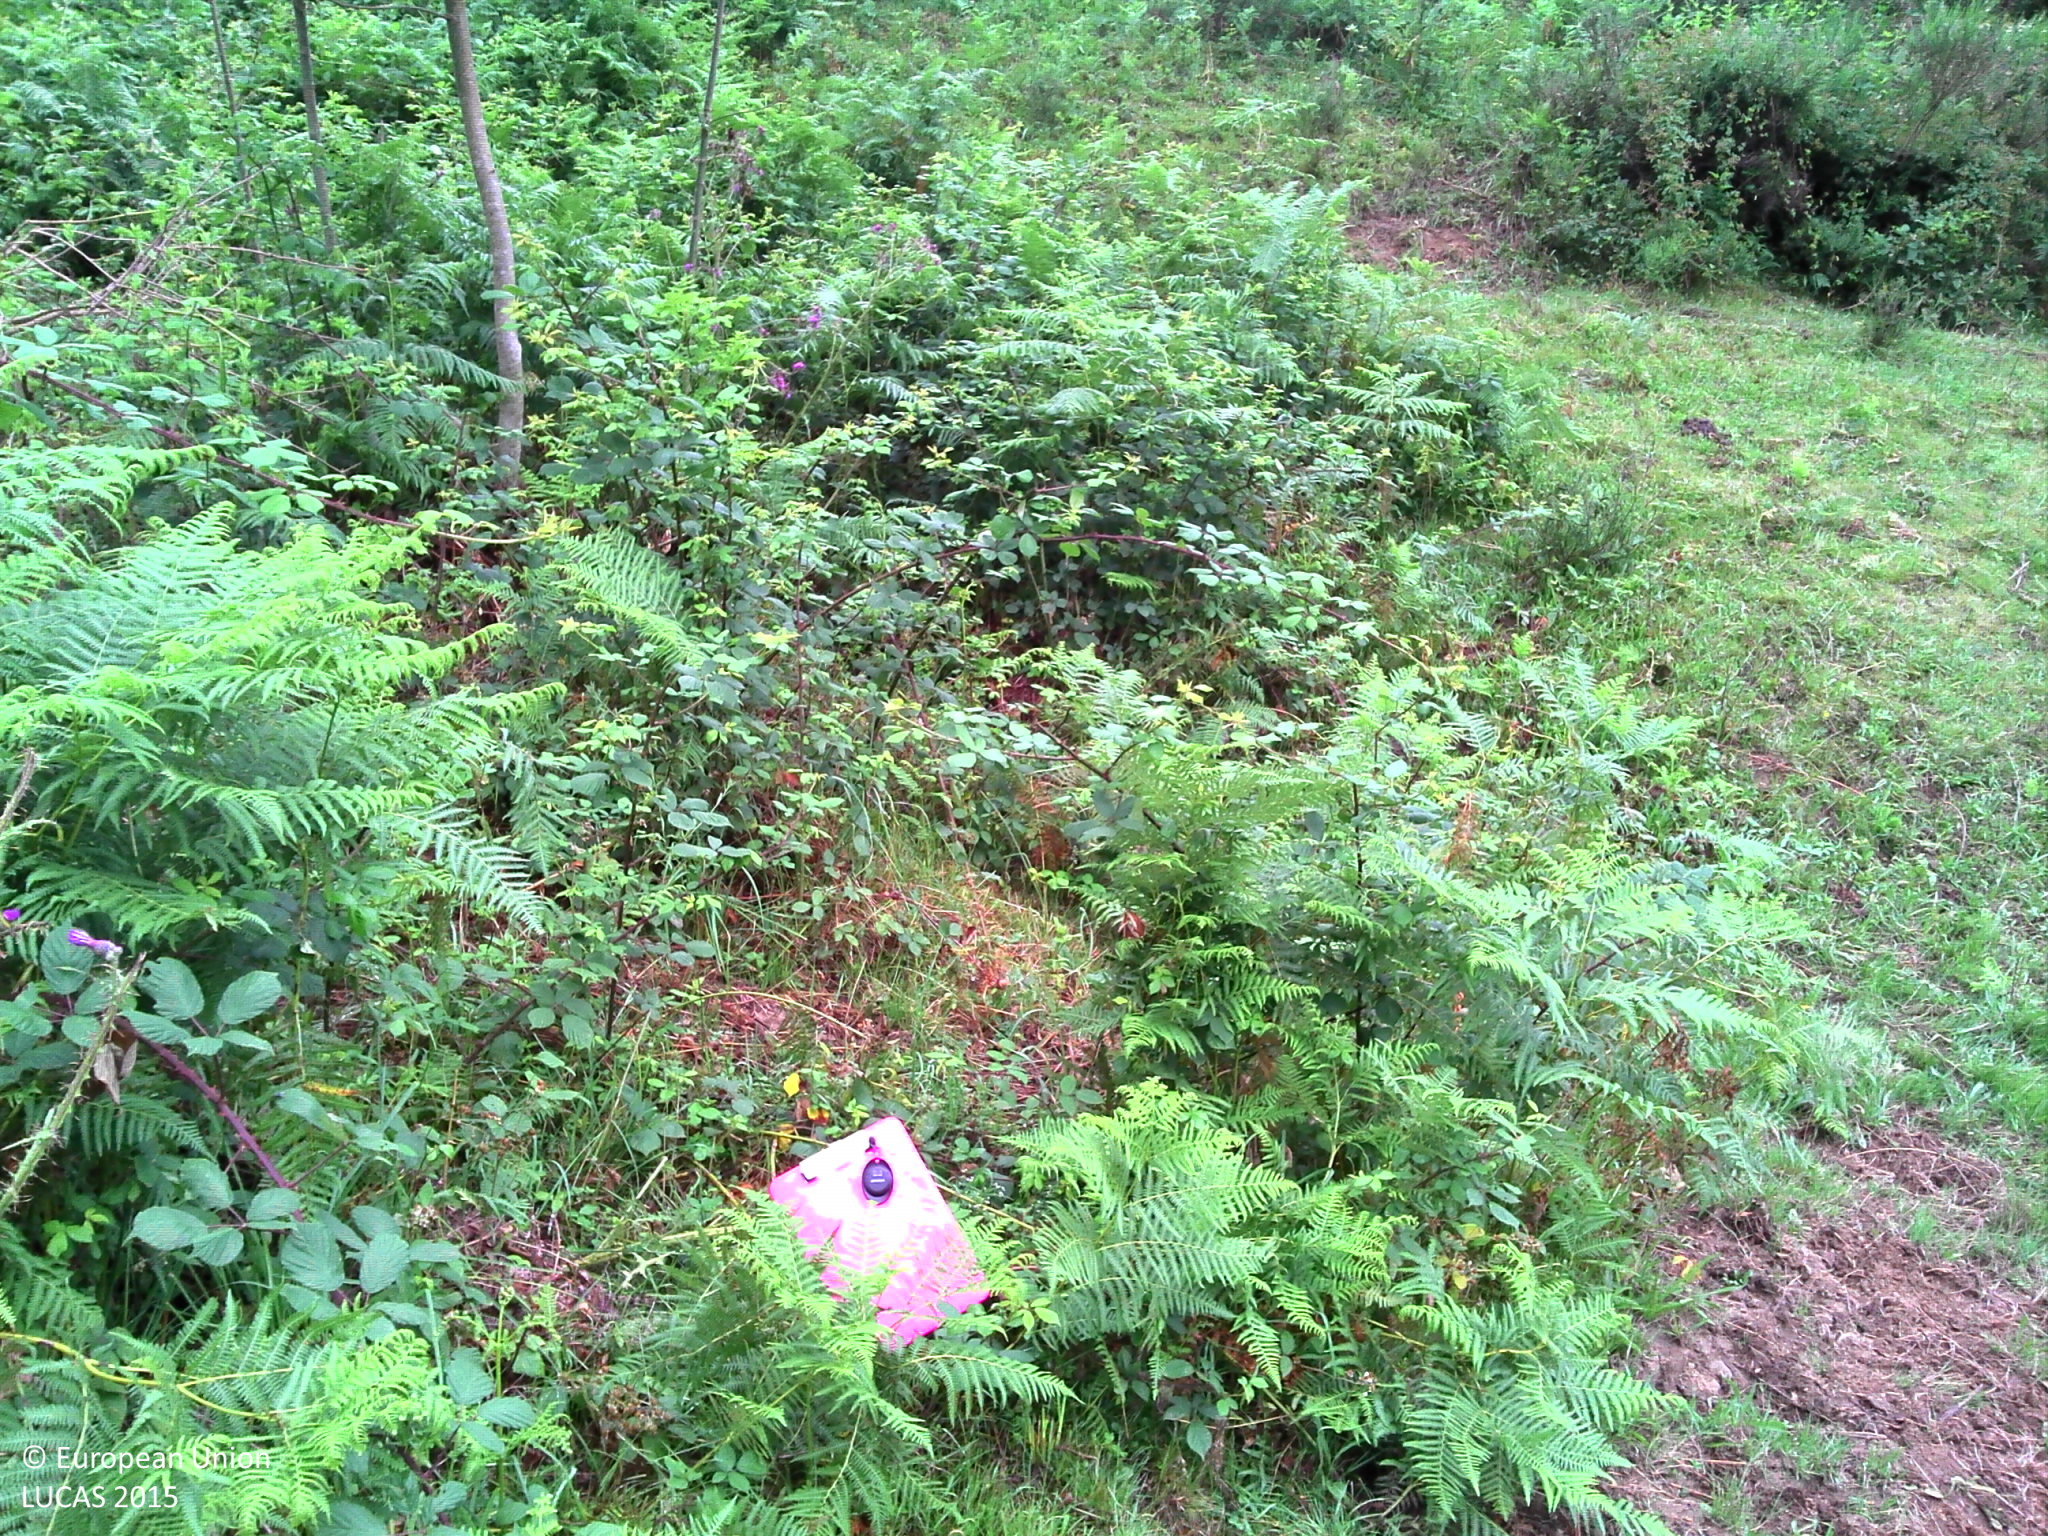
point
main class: Grassland
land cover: Grassland with sparse tree/shrub cover
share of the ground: > 75 %
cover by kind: herbaceous plants 90 %, broadleaved forest trees 5 %, shrubs 5 %
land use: Agriculture (excluding fallow land and kitchen gardens)
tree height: > 5 m
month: July
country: FR
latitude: 42.8835
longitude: 1.1533
